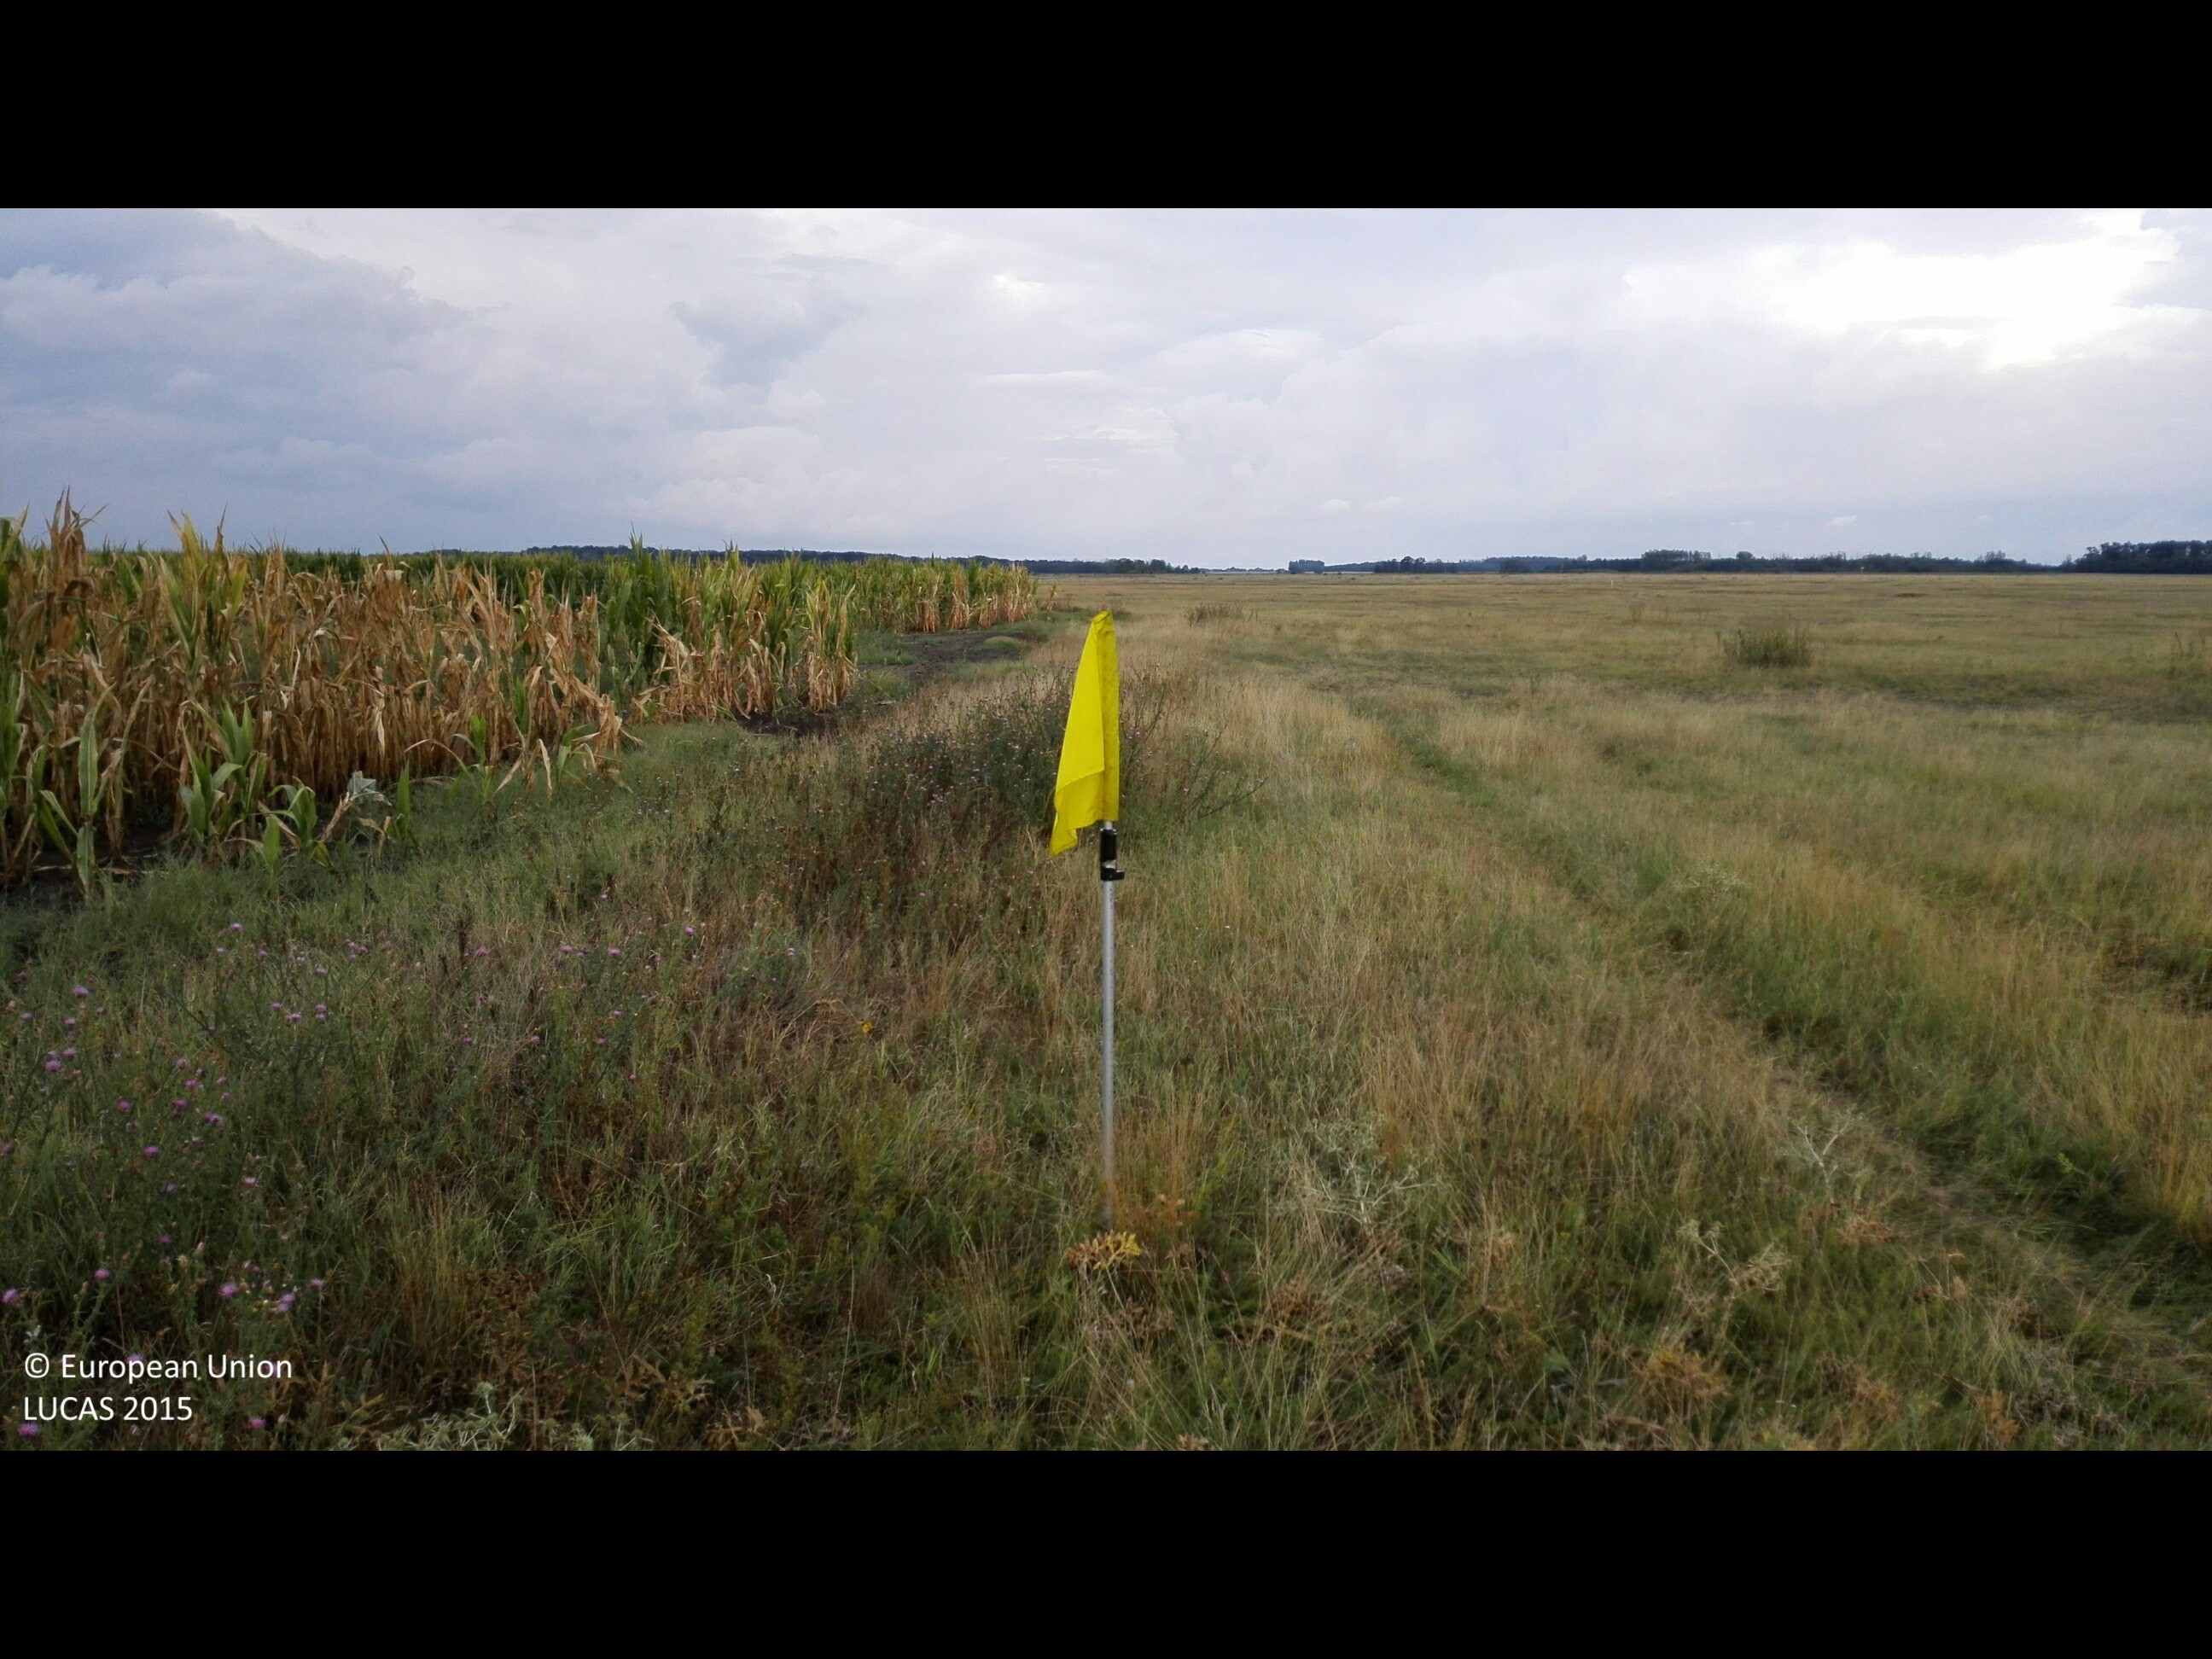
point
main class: Grassland
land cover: Grassland without tree/shrub cover
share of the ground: > 75 %
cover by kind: herbaceous plants 100 %
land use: Agriculture (excluding fallow land and kitchen gardens)
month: August
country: HU
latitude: 47.3365
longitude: 21.5968
